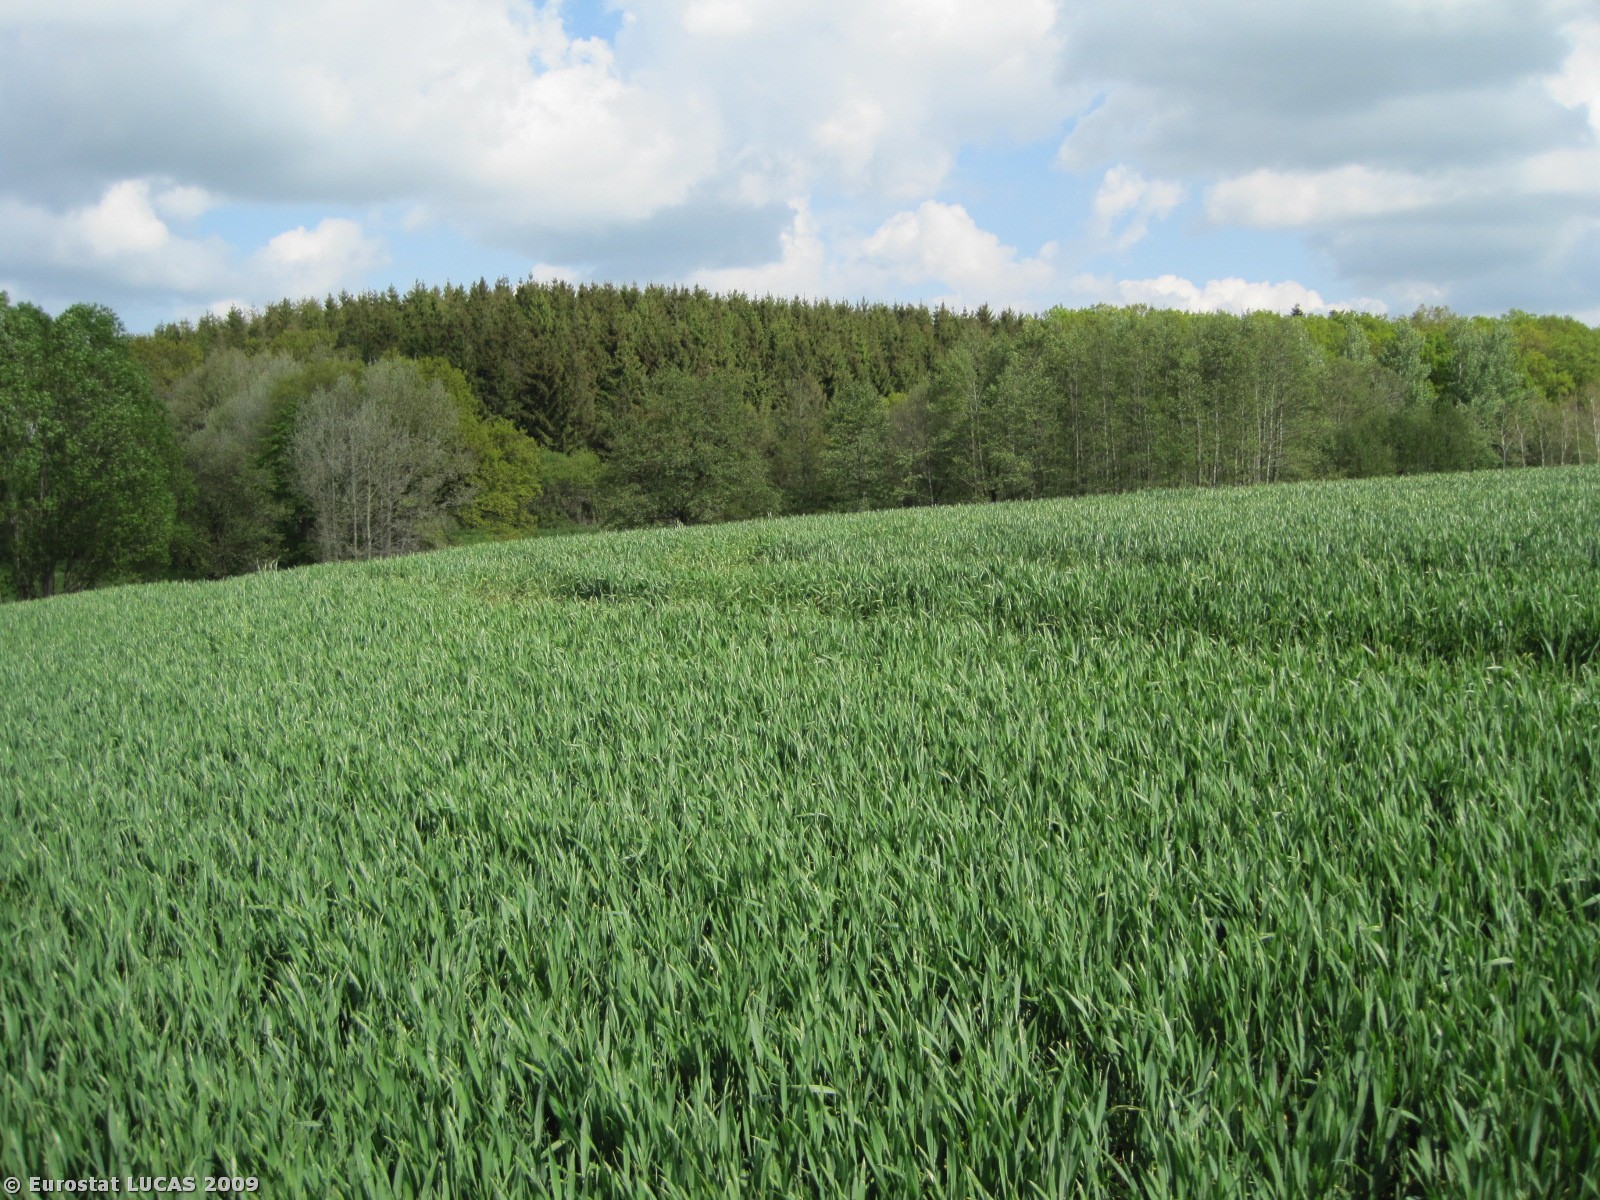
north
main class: Cropland
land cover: Common wheat
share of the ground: > 75 %
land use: Agriculture (excluding fallow land and kitchen gardens)
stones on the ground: < 10 %
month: May
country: DK
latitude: 56.3133
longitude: 9.7255
